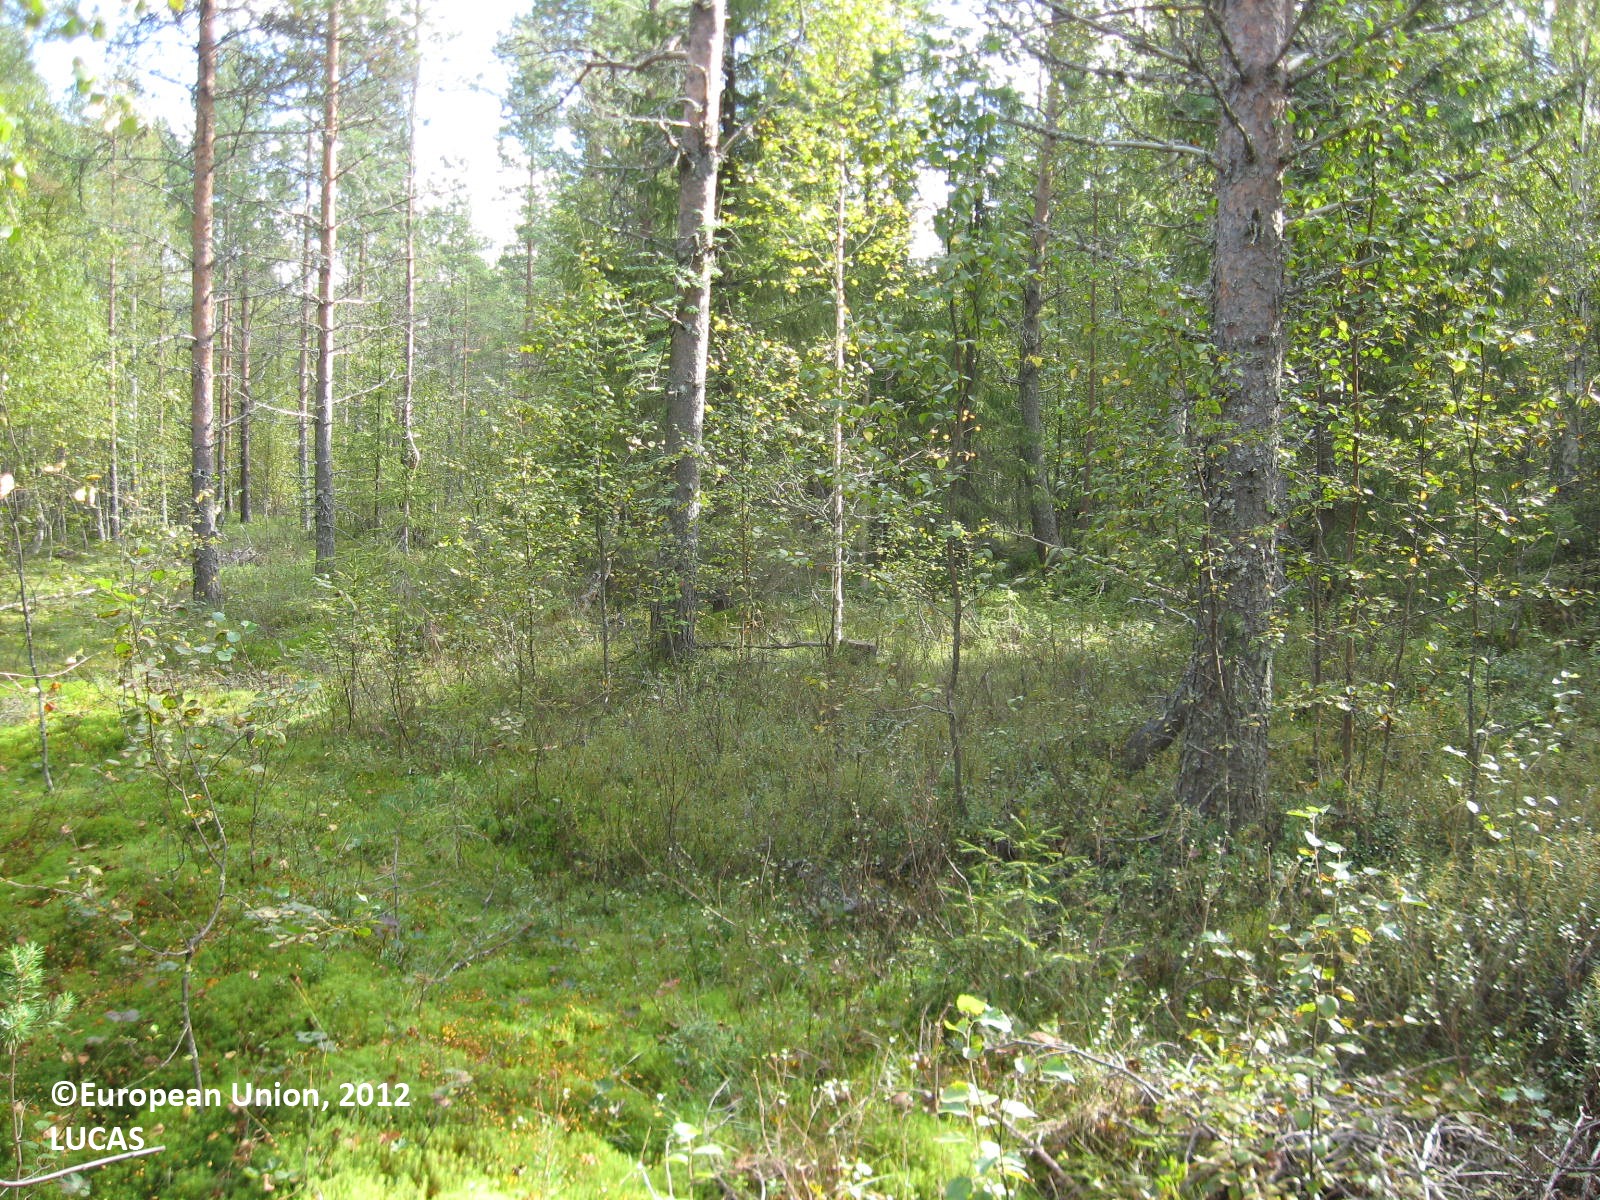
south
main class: Woodland
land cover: Other coniferous woodland
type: boreal forest
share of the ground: > 75 %
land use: Forestry
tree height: > 5 m
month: August
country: FI
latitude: 63.8155
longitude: 29.1186
